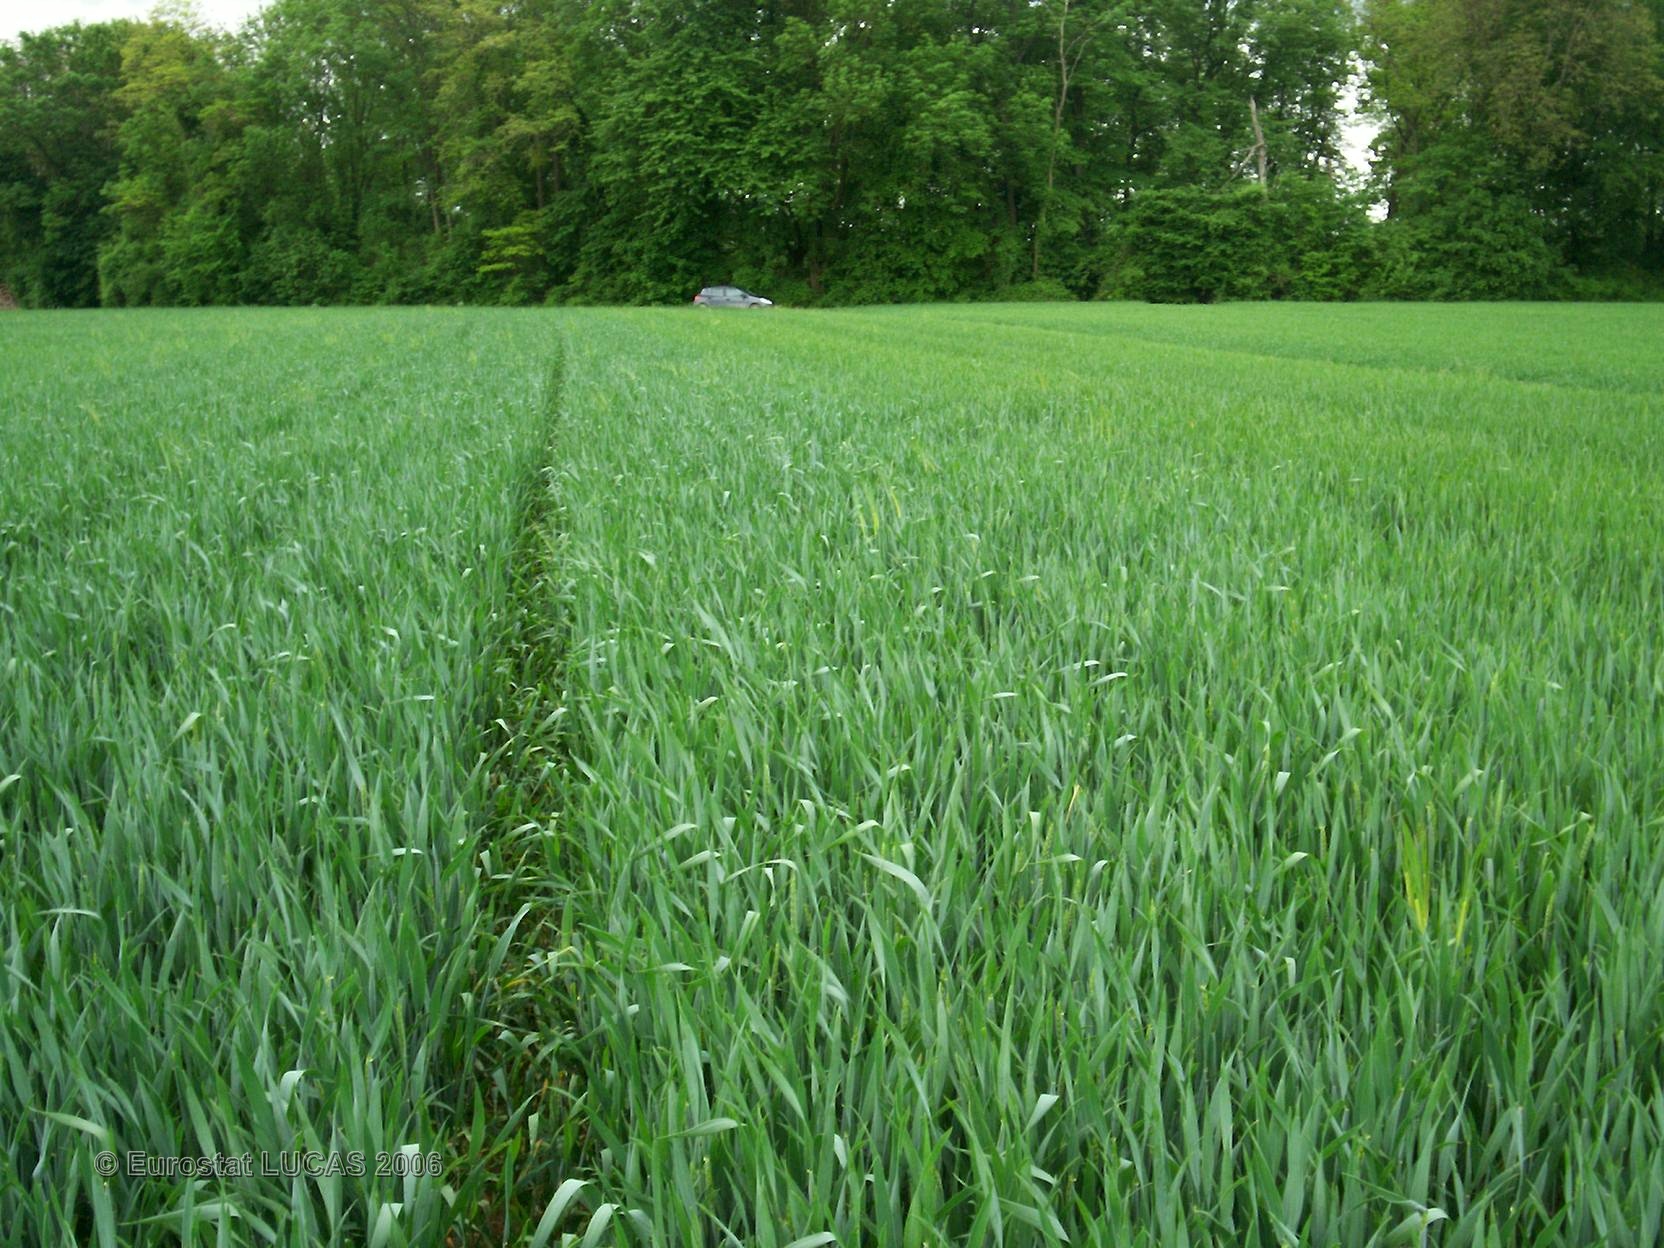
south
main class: Cropland
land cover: Common wheat
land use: Agriculture (excluding fallow land and kitchen gardens)
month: May
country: FR
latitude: 48.3584
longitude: 4.5316
